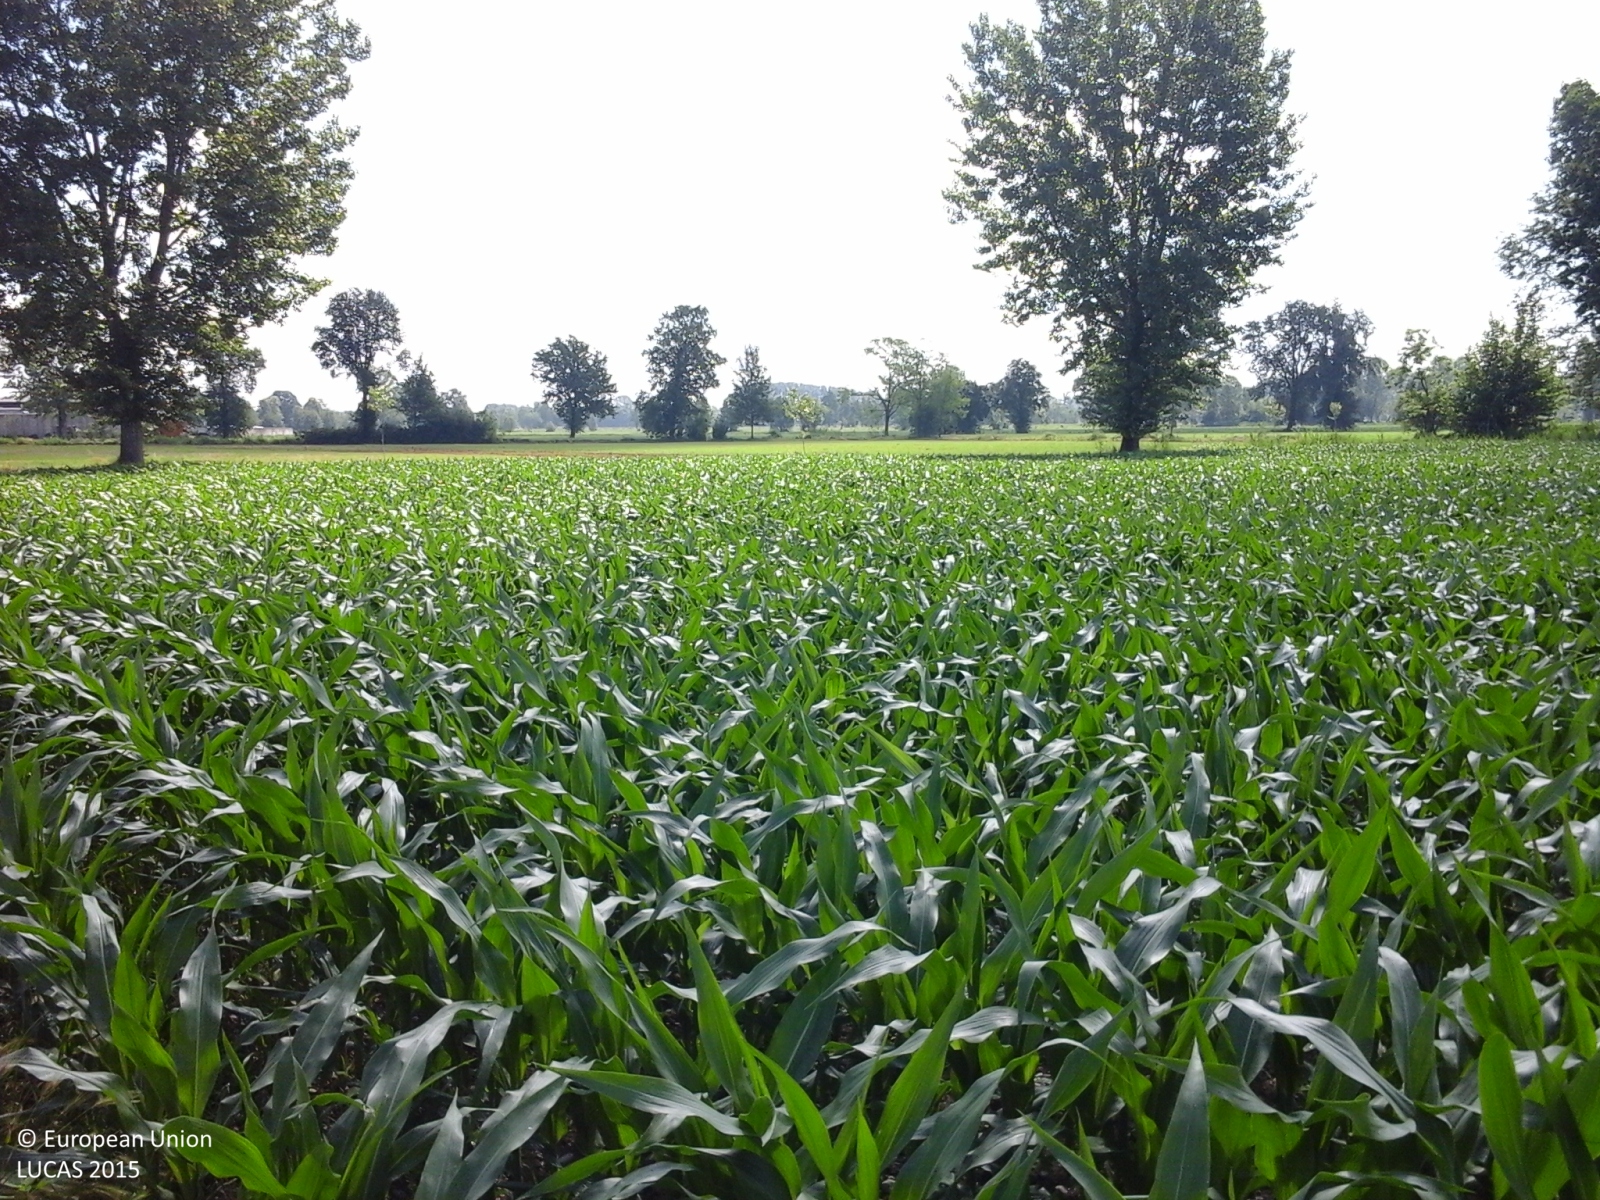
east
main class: Cropland
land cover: Maize
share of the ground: > 75 %
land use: Agriculture (excluding fallow land and kitchen gardens)
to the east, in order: Maize; Abandoned hedges; Ditches and canals; Temporary grasslands; Ditches and canals; Single bushes/trees; Temporary grasslands
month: May
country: IT
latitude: 45.3773
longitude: 9.5538
